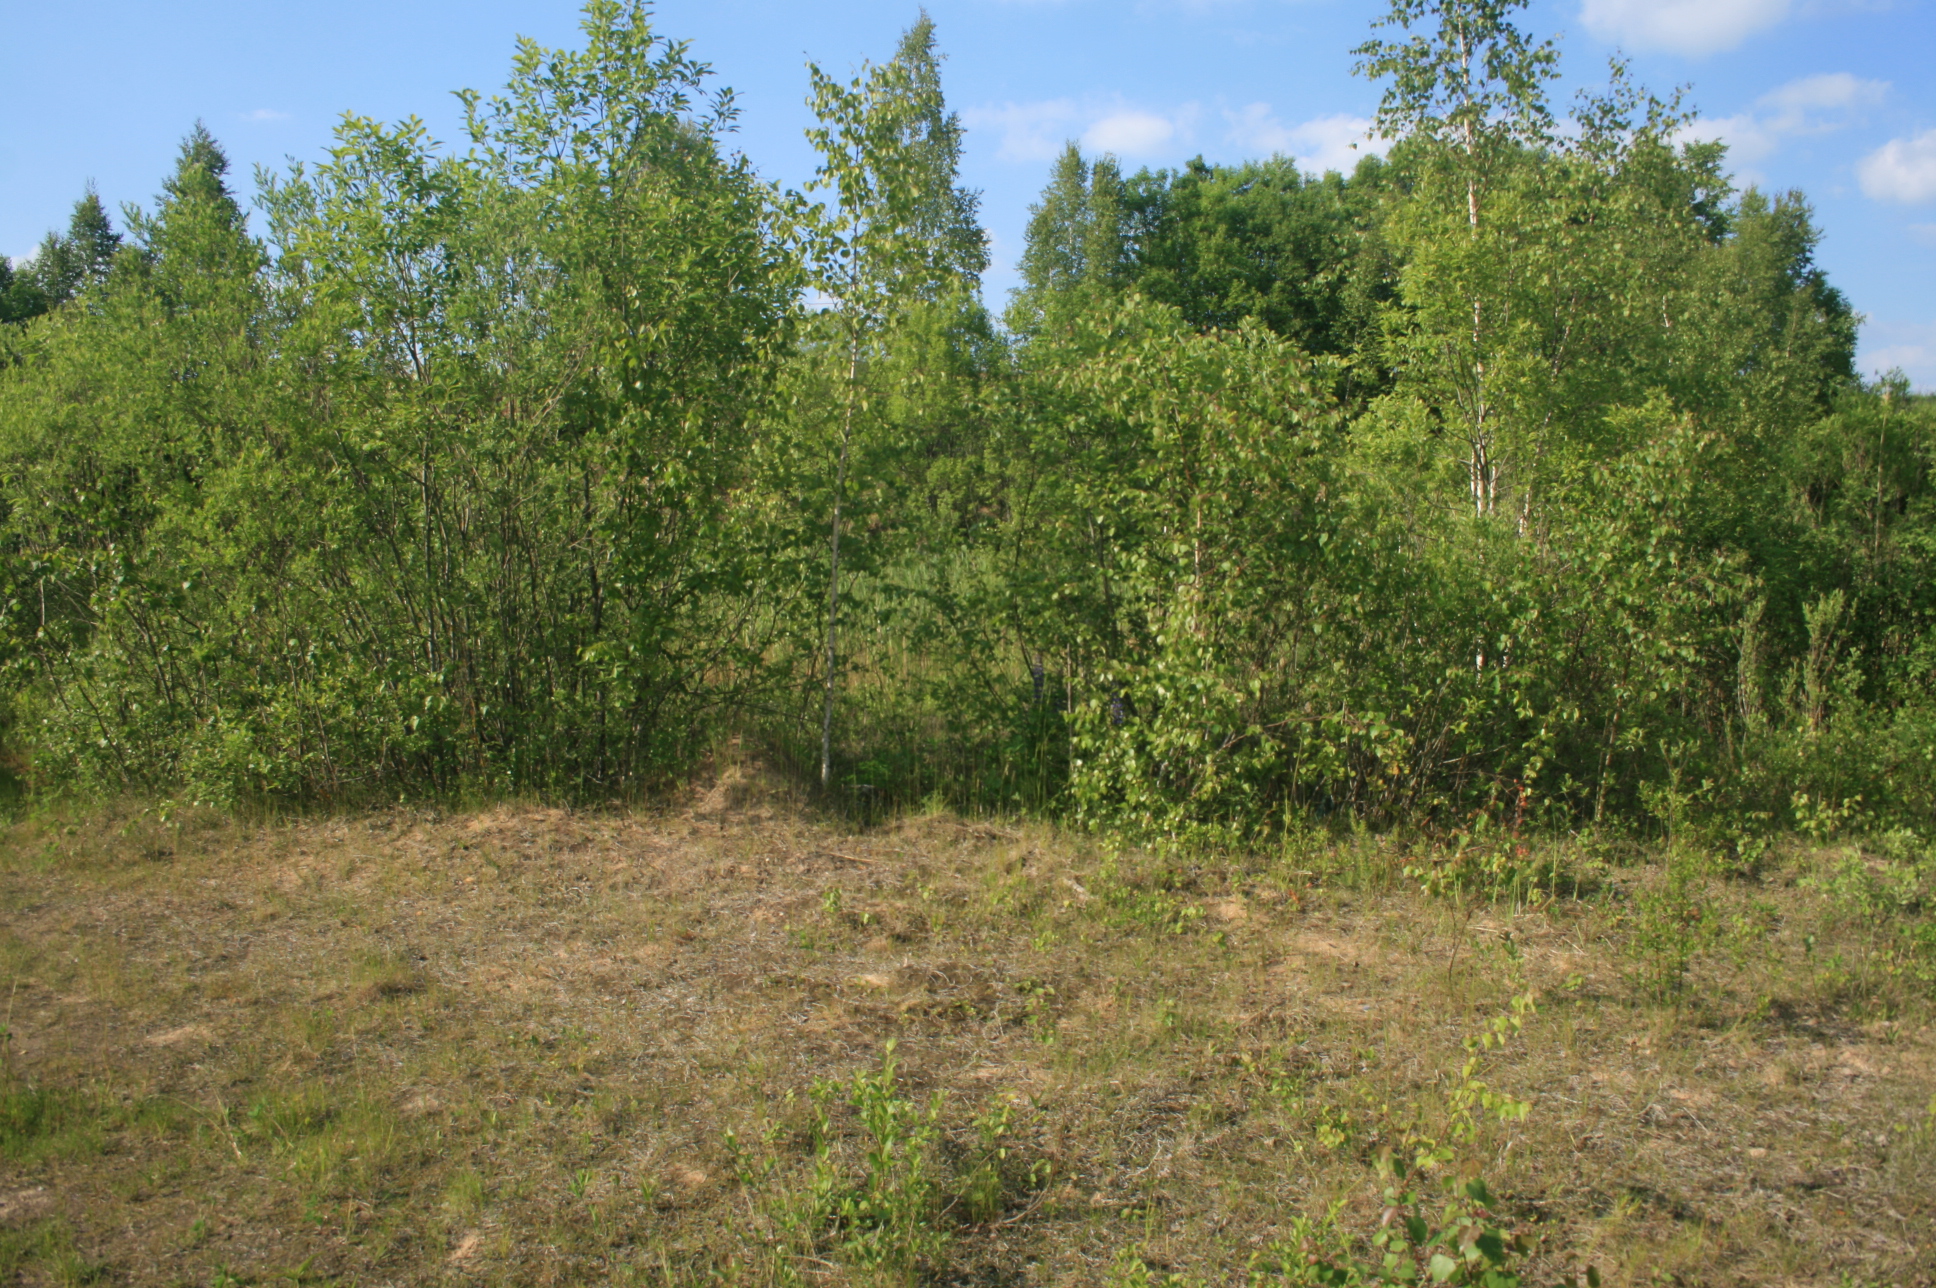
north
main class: Woodland
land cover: Broadleaved woodland
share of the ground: 50 - 75 %
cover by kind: broadleaved forest trees 60 %, herbaceous plants 25 %, unconsolidated bare surface 15 %
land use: Forestry
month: June
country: LT
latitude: 55.6385
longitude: 22.2091
